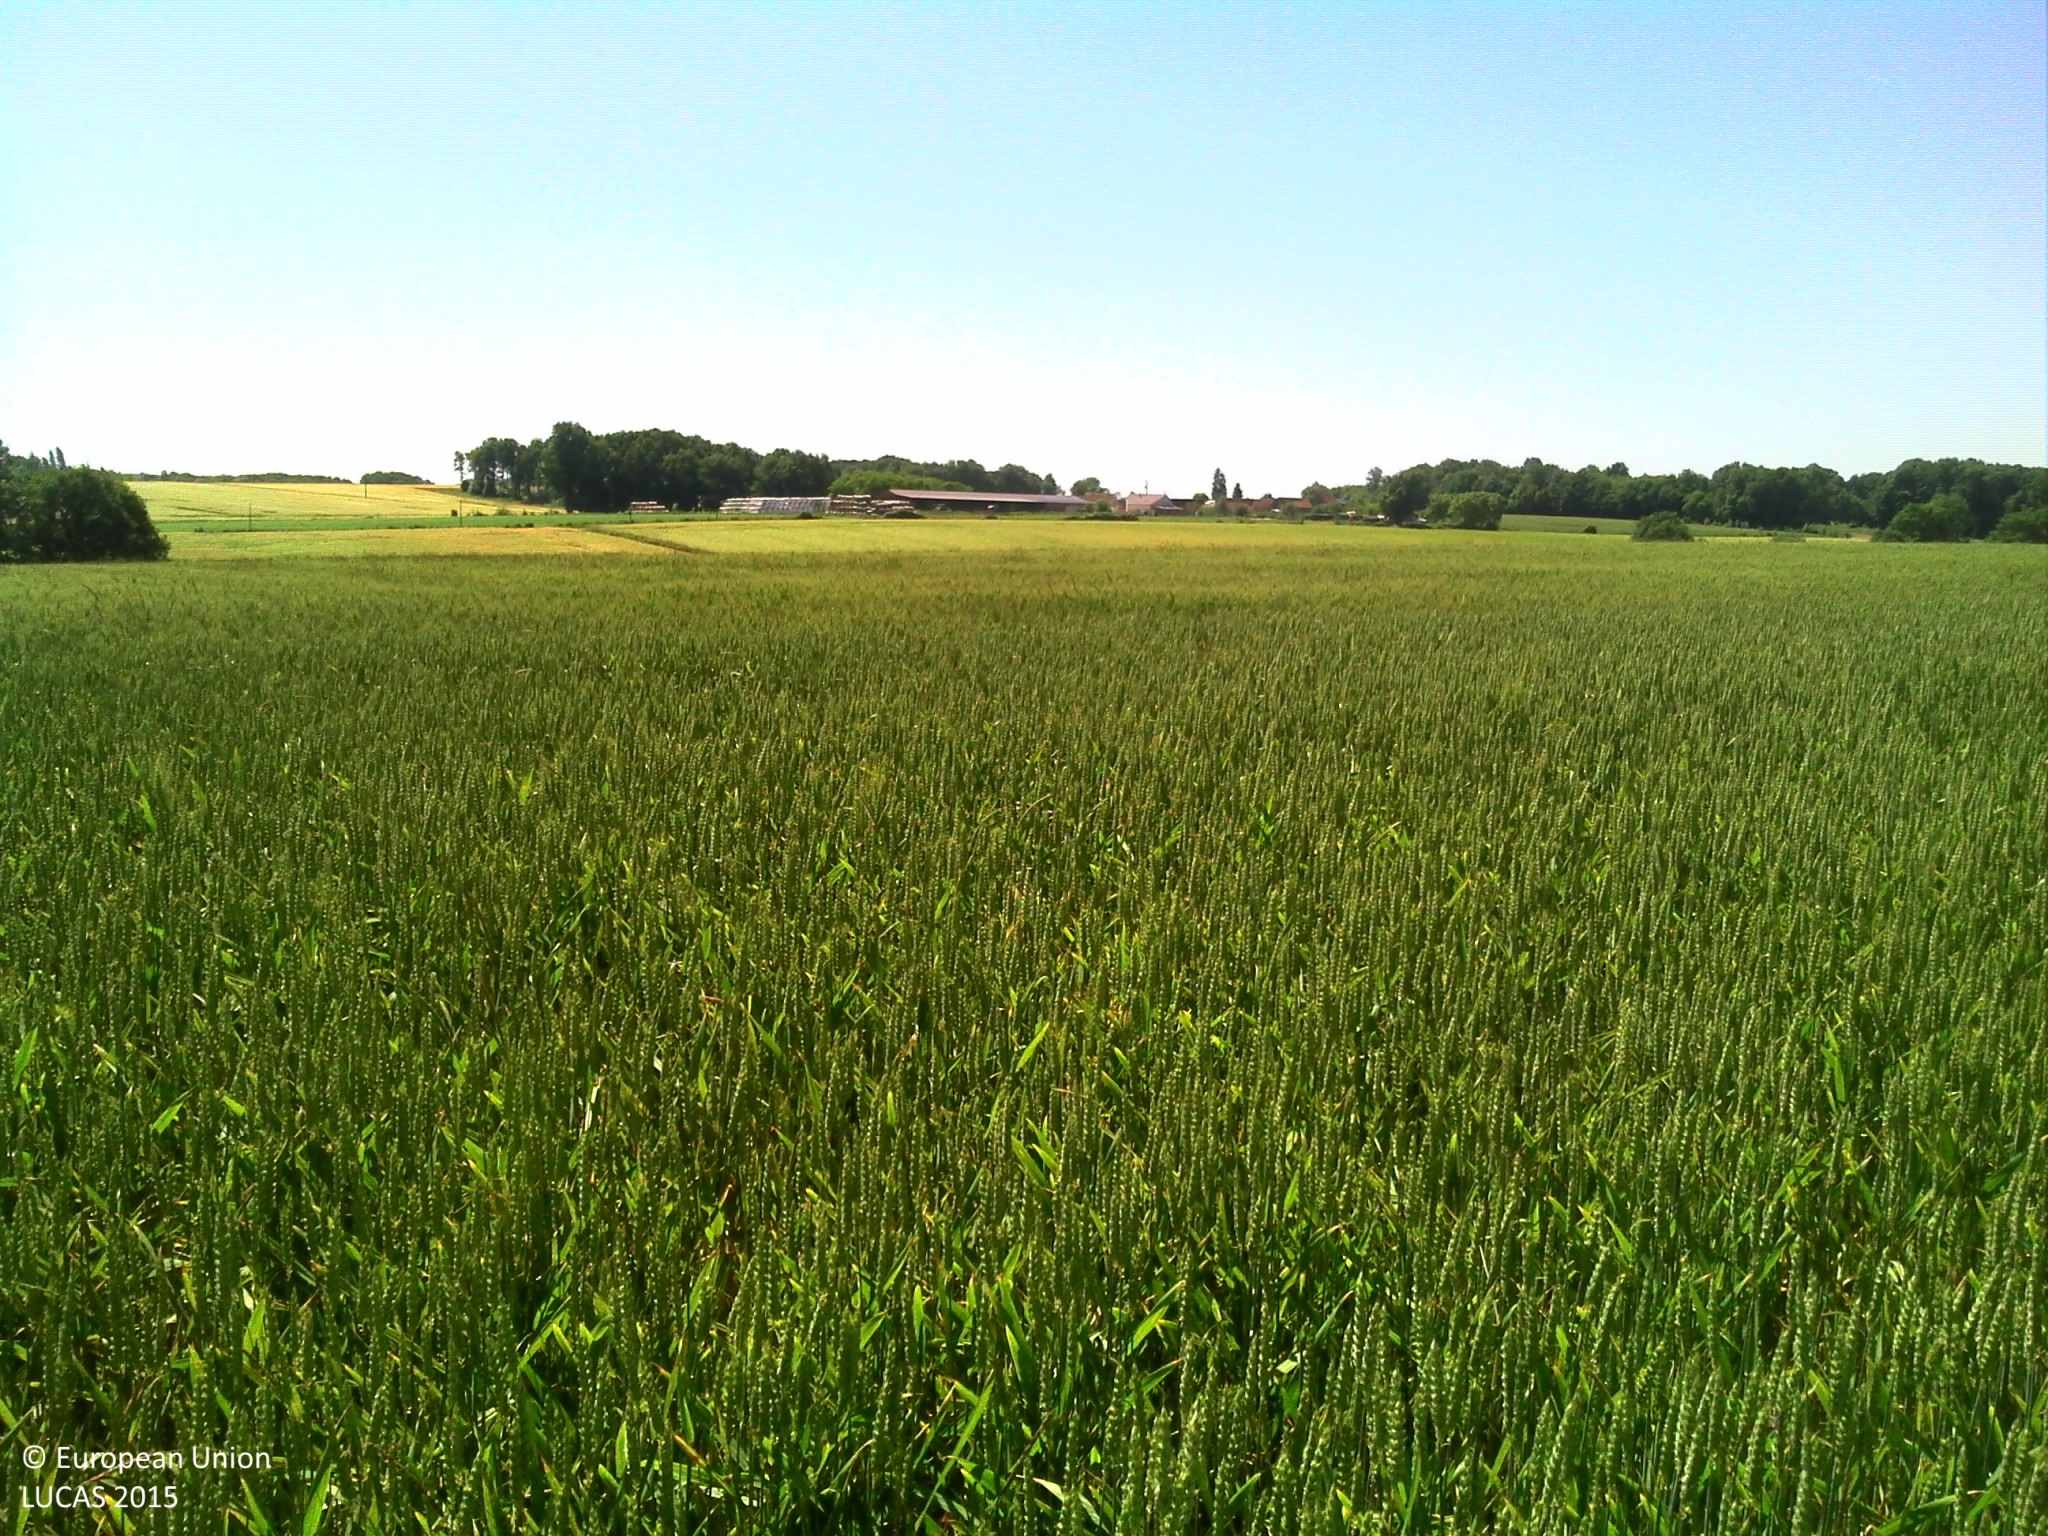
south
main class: Cropland
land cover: Common wheat
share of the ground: > 75 %
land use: Agriculture (excluding fallow land and kitchen gardens)
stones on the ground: < 10 %
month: June
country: FR
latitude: 47.1304
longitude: 1.2187
